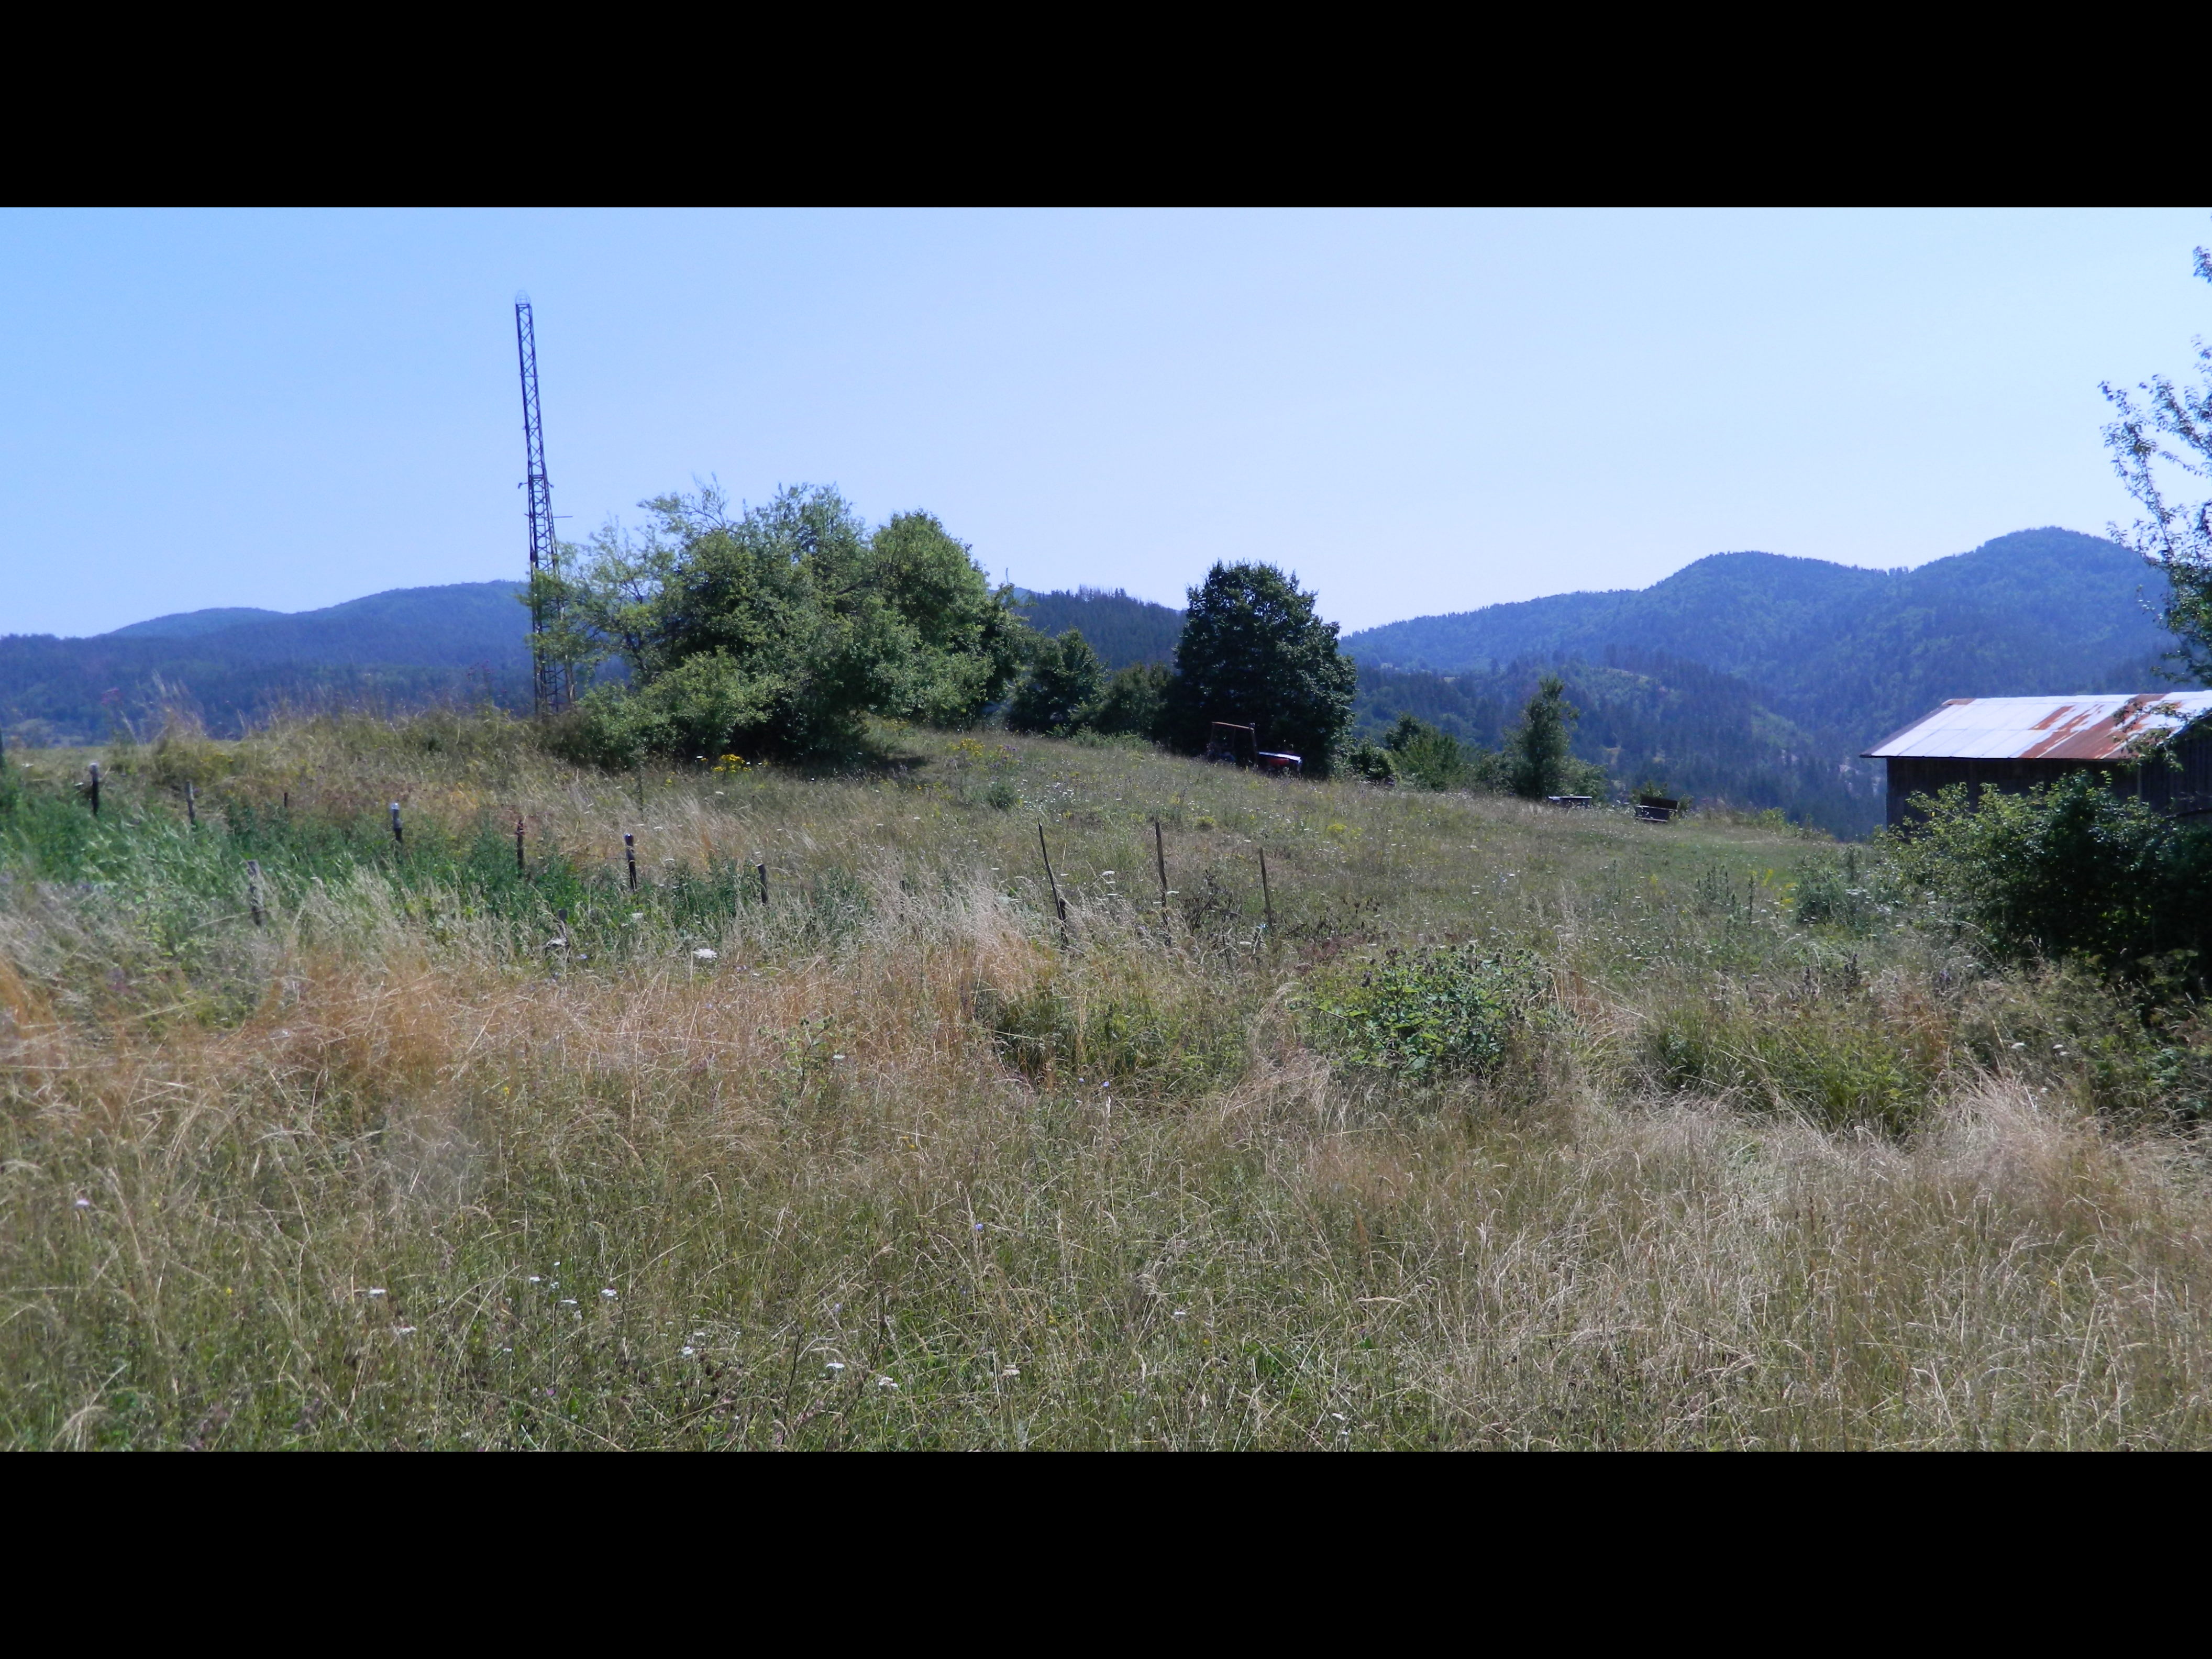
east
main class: Grassland
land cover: Grassland without tree/shrub cover
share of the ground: > 75 %
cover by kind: herbaceous plants 100 %
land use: Agriculture (excluding fallow land and kitchen gardens)
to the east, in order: Grassland without tree/shrub cover; Fences; Grassland without tree/shrub cover; Tracks; Abandoned hedges; Grassland without tree/shrub cover; Fences; Grassland with sparse tree/shrub cover; Fences; Broadleaved woodland; Tracks; Fences; Abandoned hedges; Grassland without tree/shrub cover
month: July
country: BG
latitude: 41.5272
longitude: 24.7733
